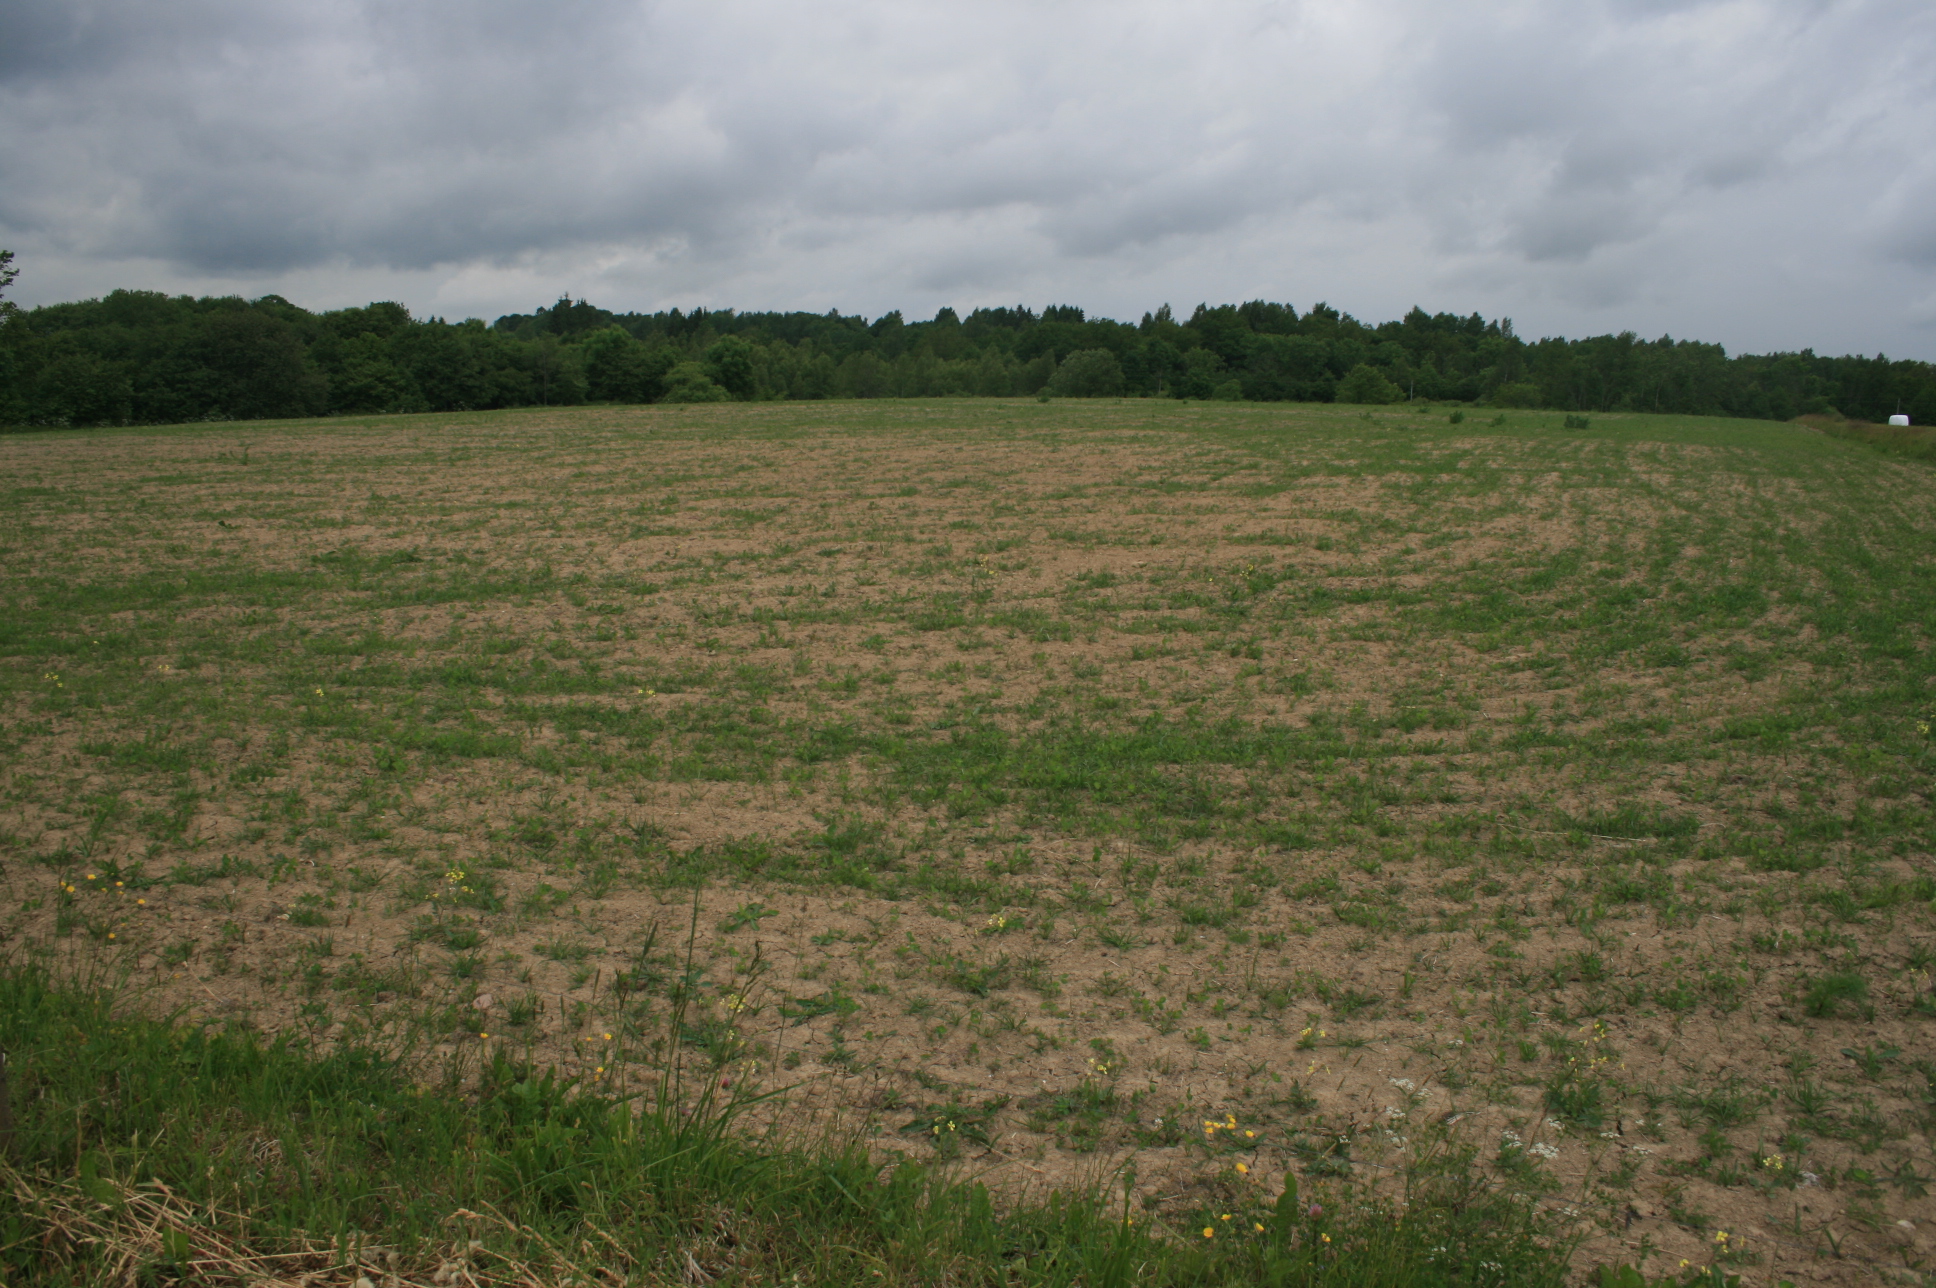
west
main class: Grassland
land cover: Grassland without tree/shrub cover
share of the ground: > 75 %
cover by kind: herbaceous plants 100 %
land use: Agriculture (excluding fallow land and kitchen gardens)
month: June
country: LT
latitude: 55.5848
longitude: 22.3859
